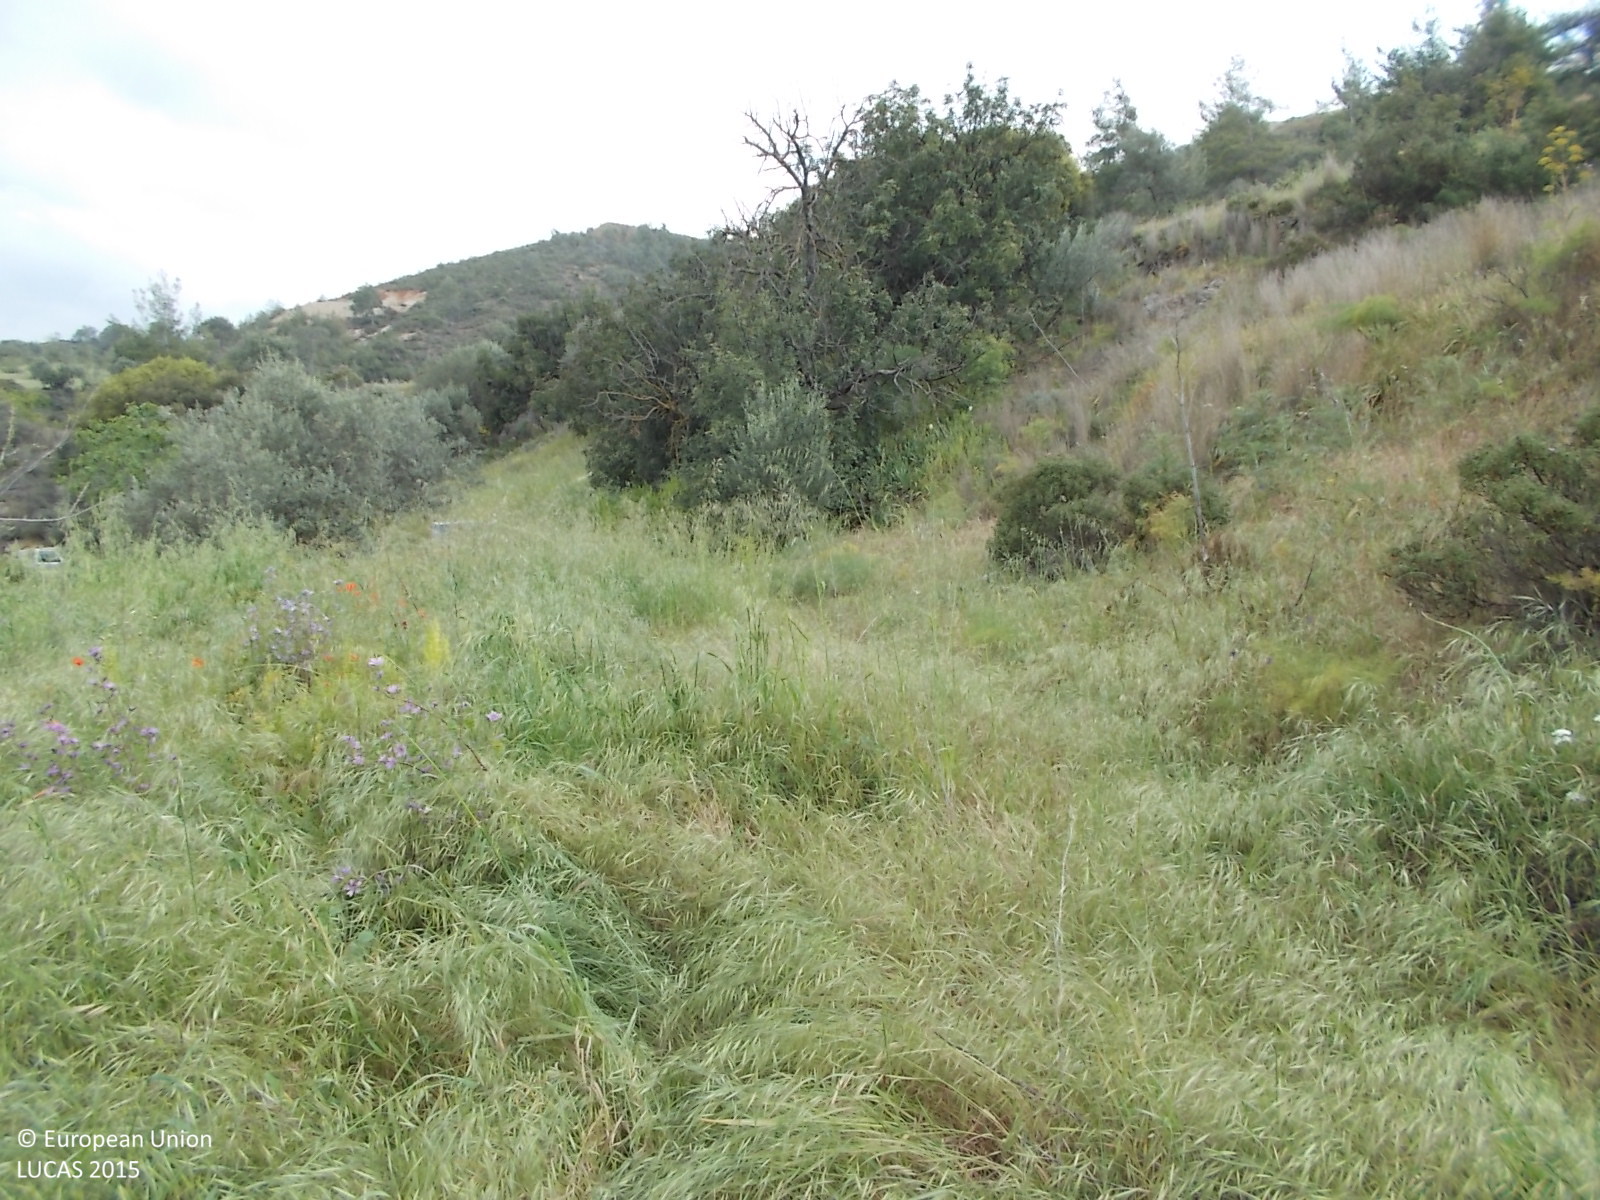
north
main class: Grassland
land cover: Spontaneously vegetated surfaces
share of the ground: > 75 %
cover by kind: herbaceous plants 100 %
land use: Fallow land
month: April
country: CY
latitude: 34.8140
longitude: 33.1414
